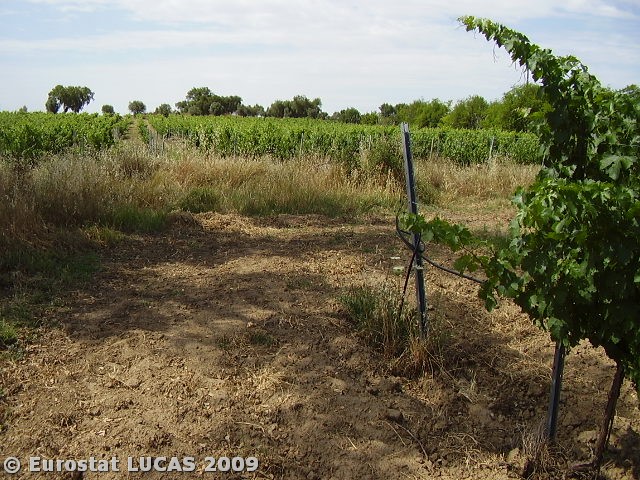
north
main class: Cropland
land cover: Vineyards
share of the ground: 25 - 50 %
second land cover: Bare land
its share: 25 - 50 %
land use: Agriculture (excluding fallow land and kitchen gardens)
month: June
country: PT
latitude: 38.5320
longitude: -7.8996
